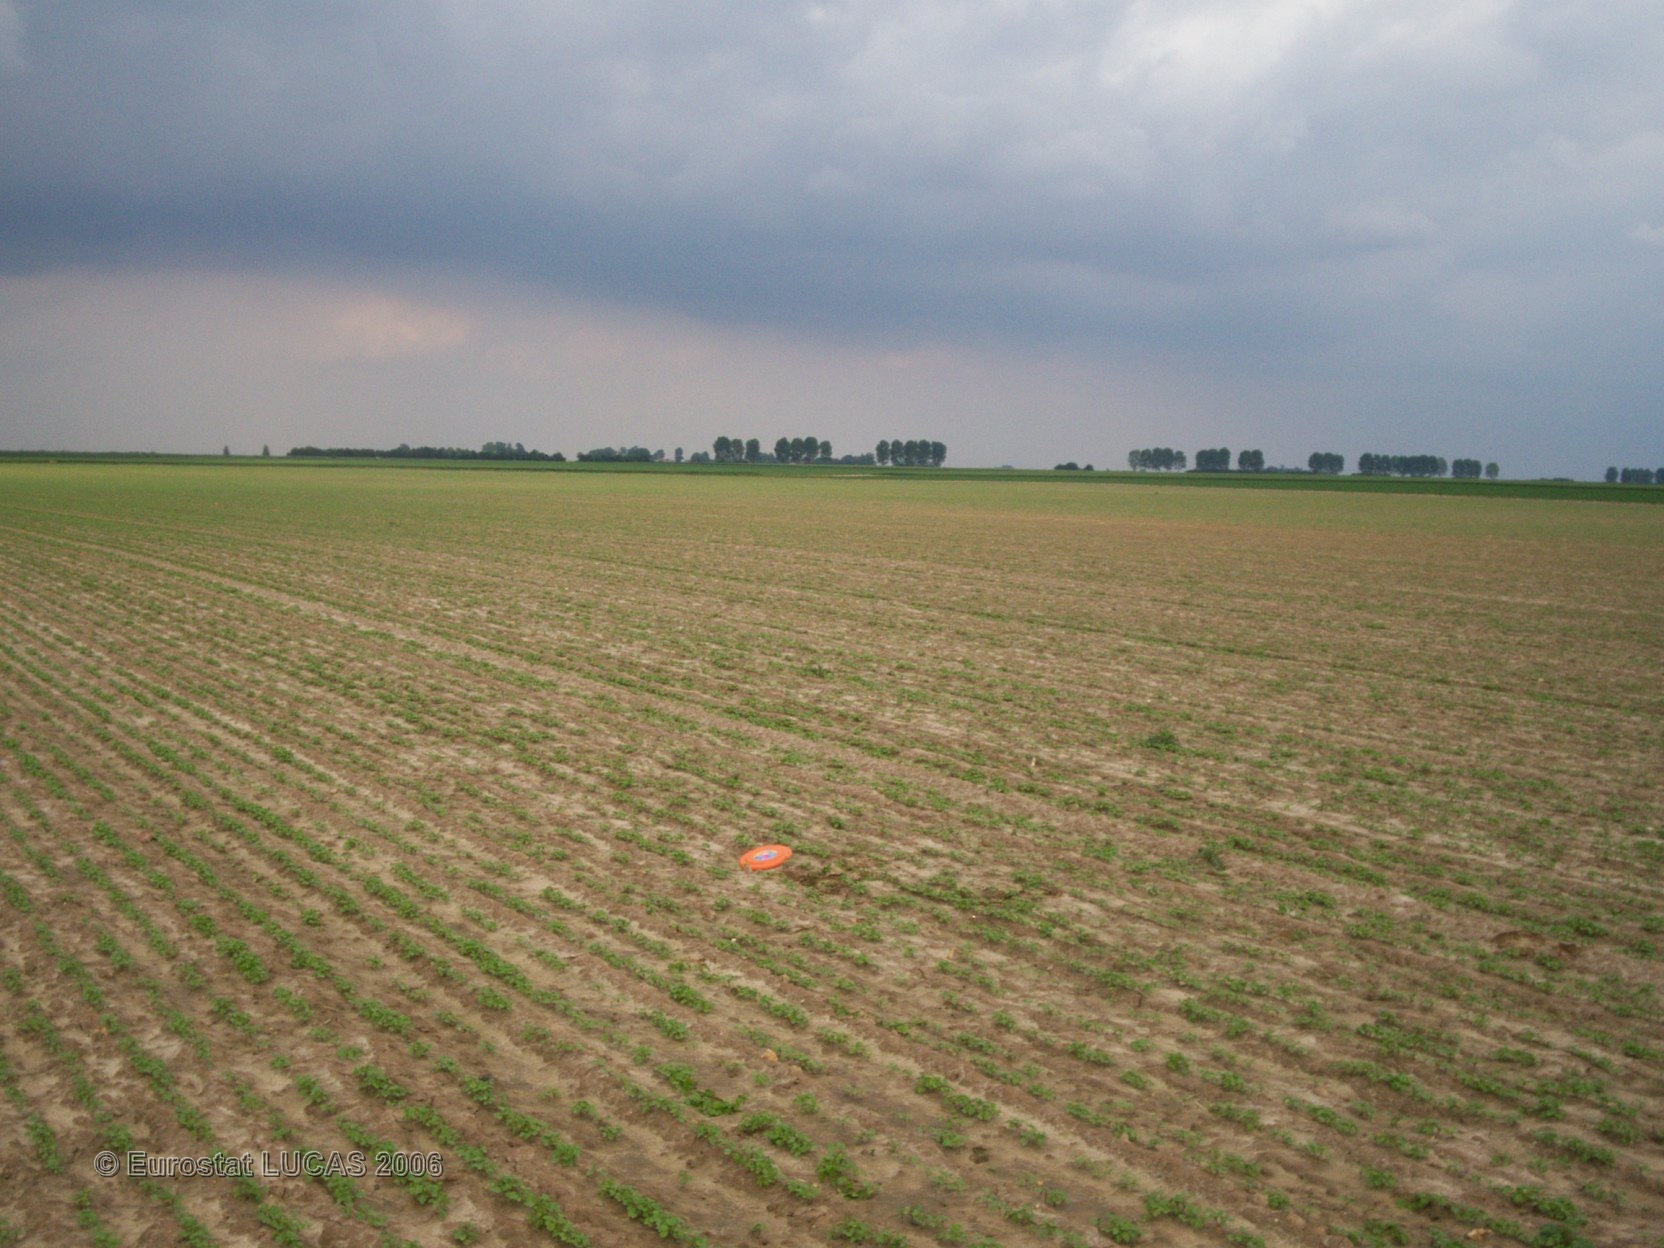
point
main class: Cropland
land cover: Other root crops
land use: Agriculture (excluding fallow land and kitchen gardens)
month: June
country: FR
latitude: 49.7319
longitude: 2.6772
